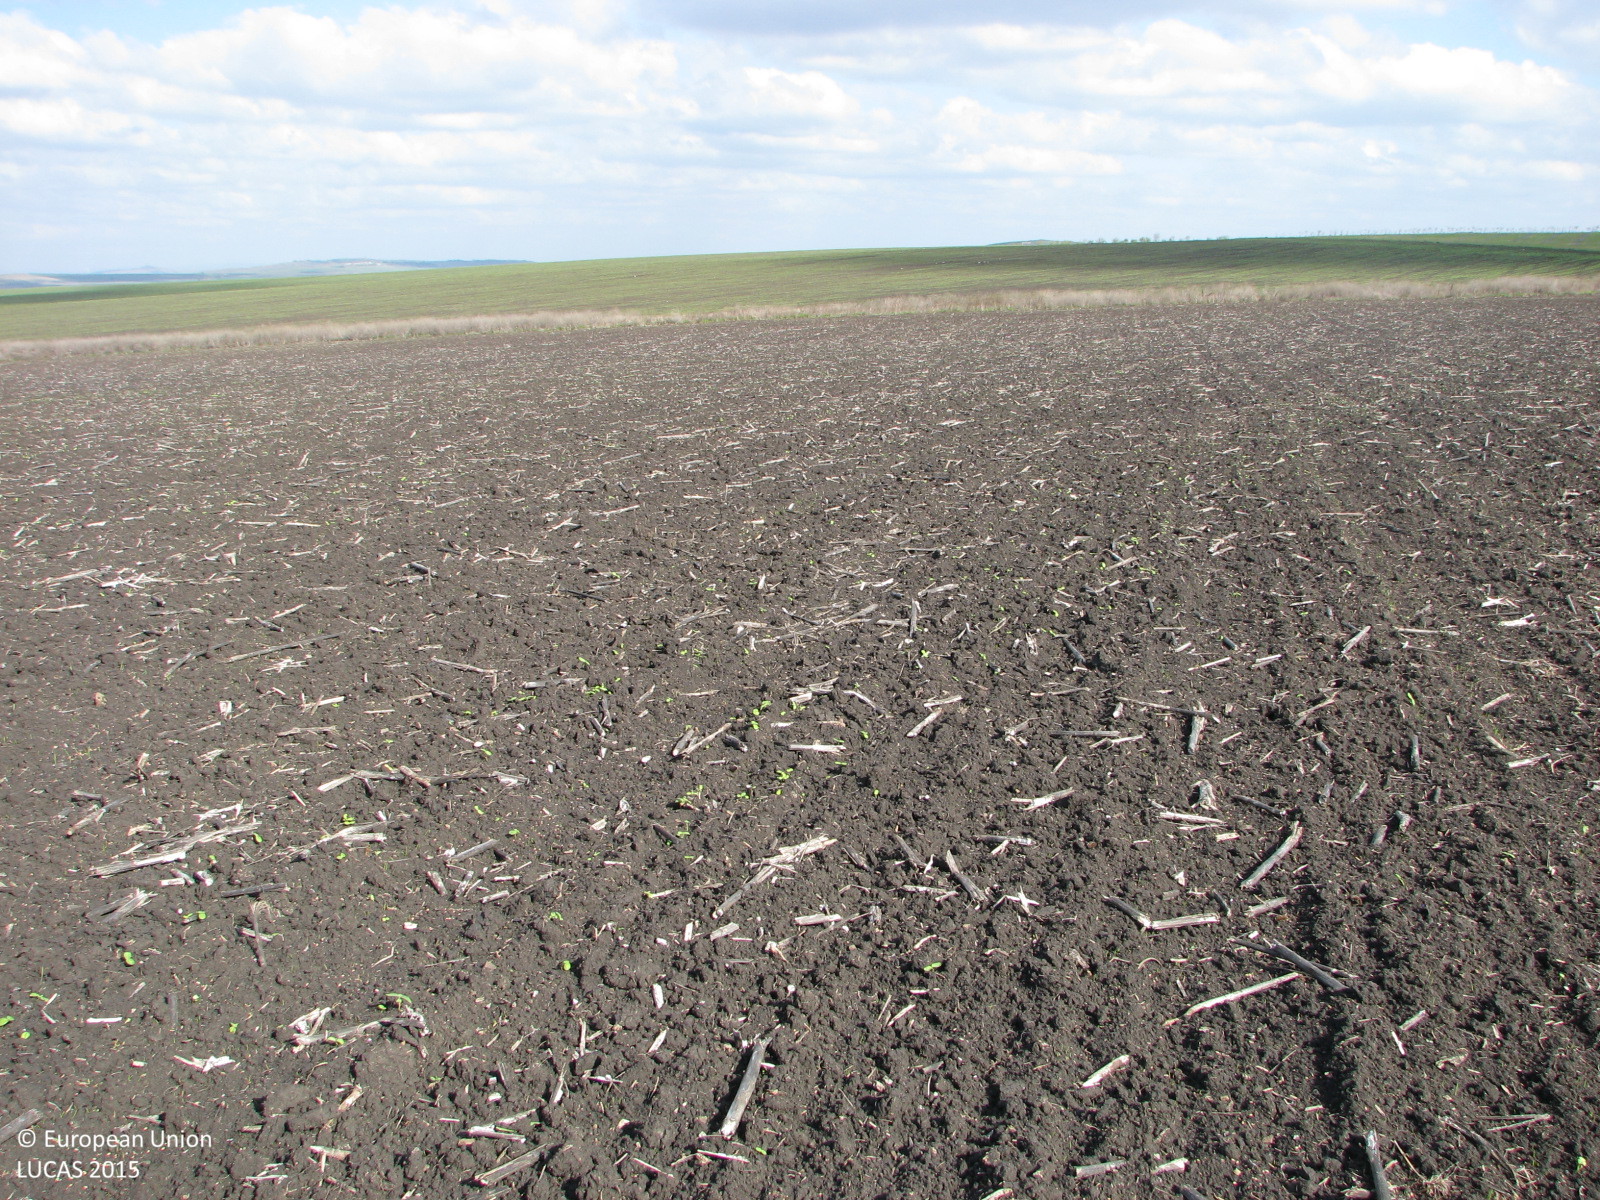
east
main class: Cropland
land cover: Common wheat
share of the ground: < 10 %
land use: Agriculture (excluding fallow land and kitchen gardens)
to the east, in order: Common wheat; Grass margins; Tracks; Grass margins; Other bare soil; Nuts trees
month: November
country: BG
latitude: 42.4993
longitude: 26.8569
